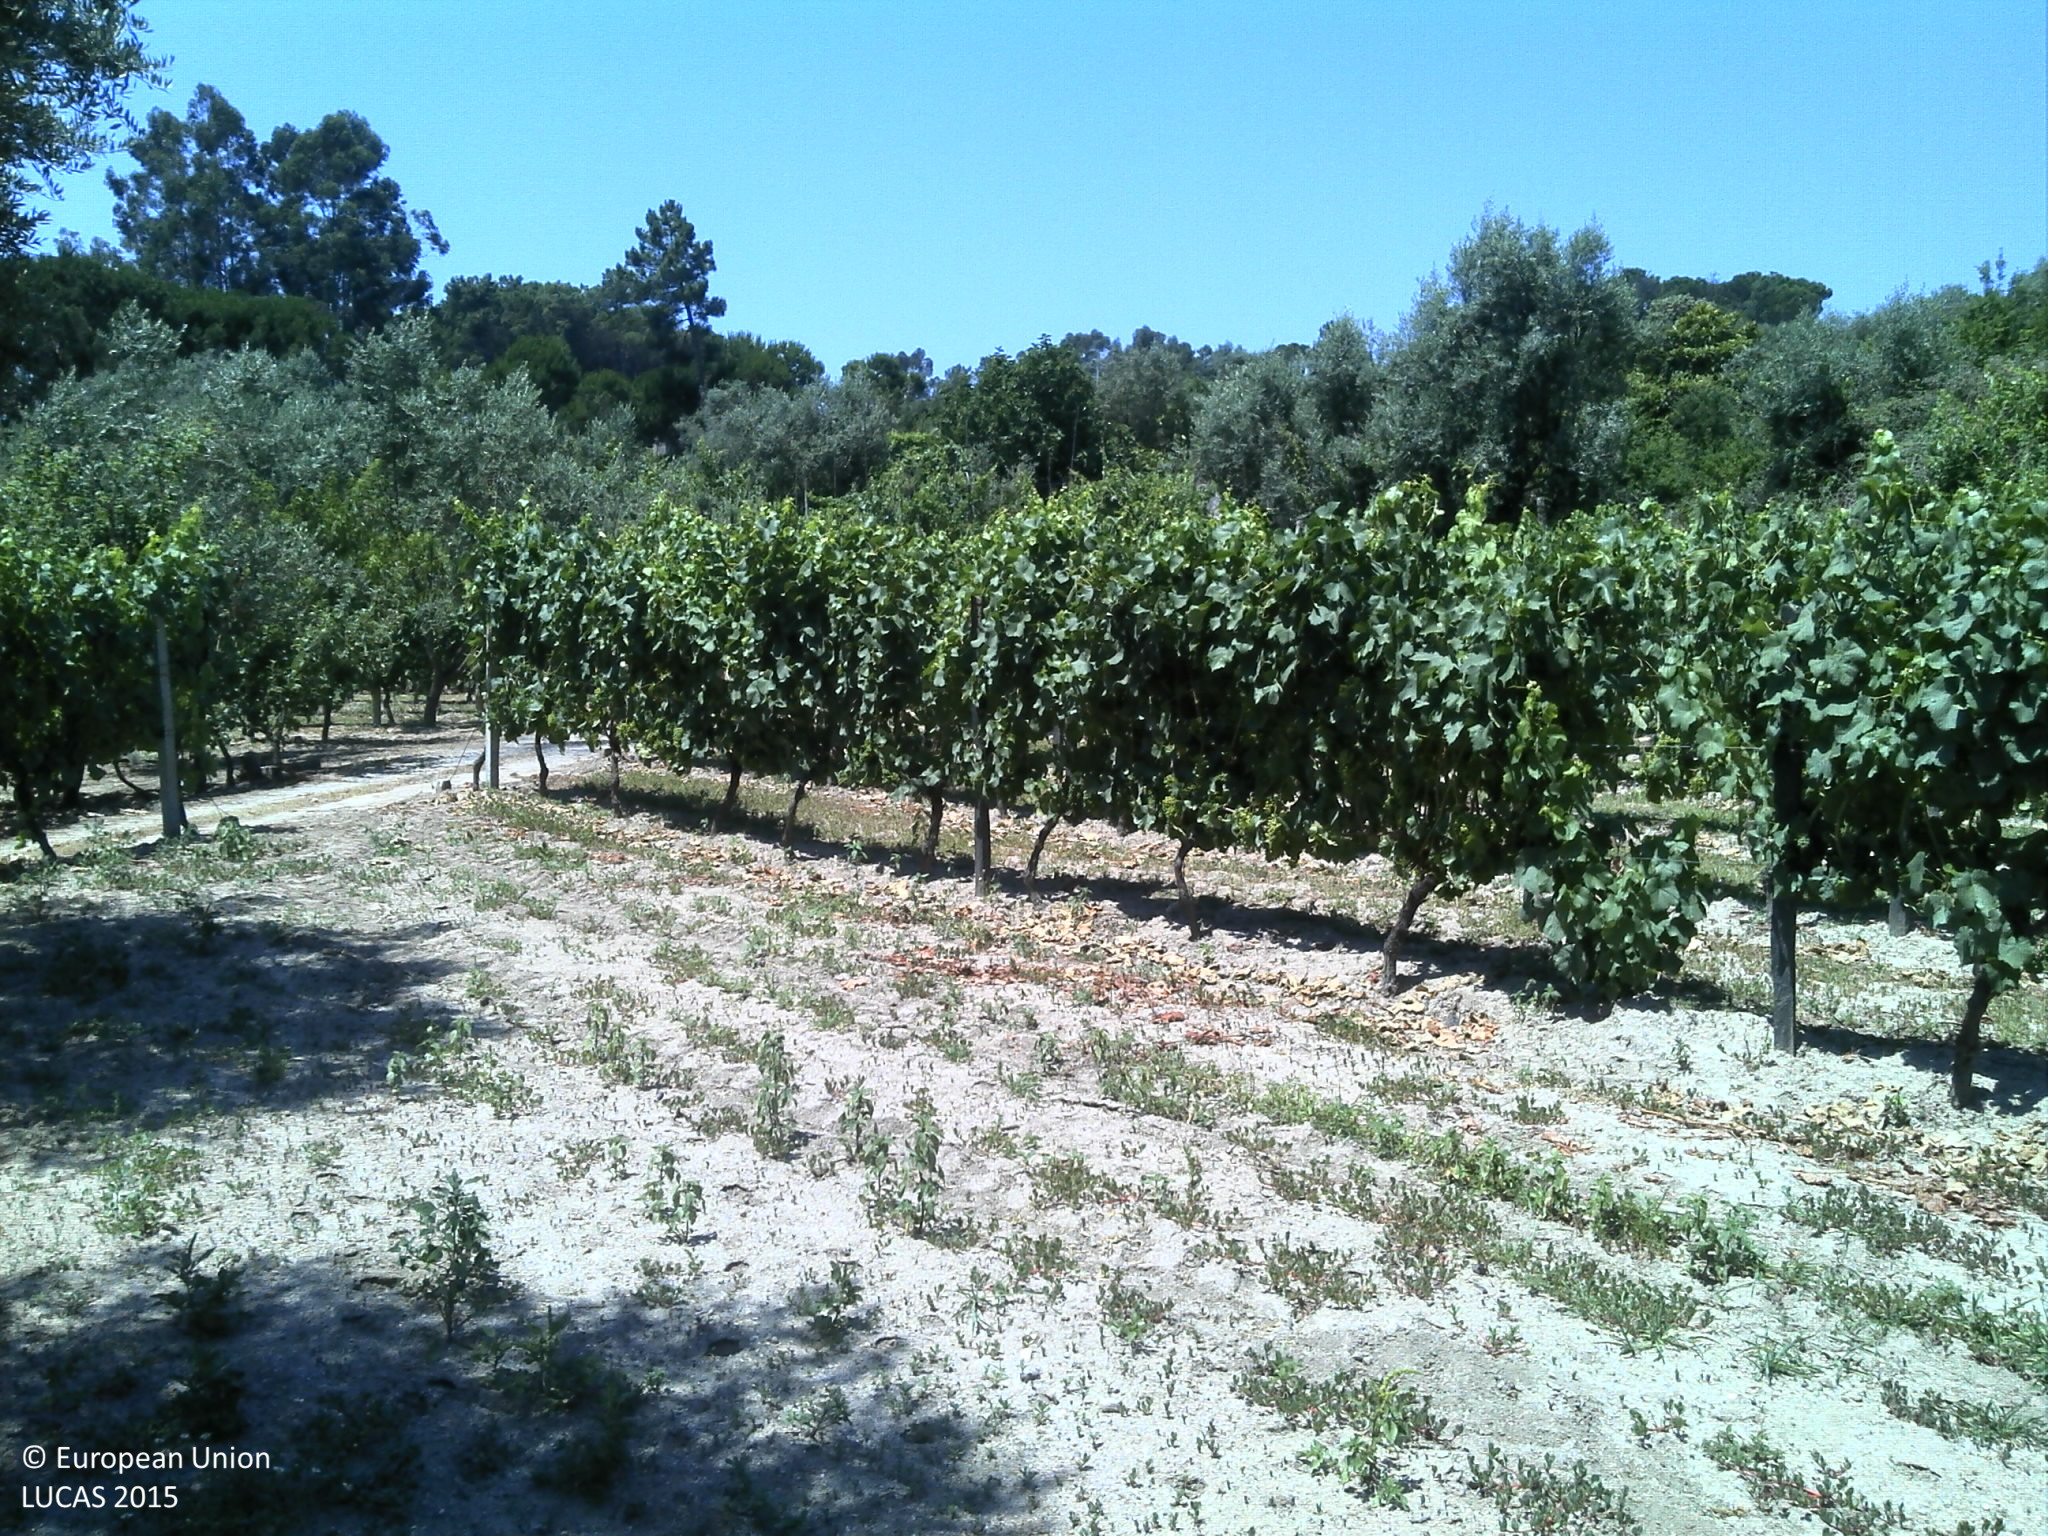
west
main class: Grassland
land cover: Grassland with sparse tree/shrub cover
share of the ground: 10 - 25 %
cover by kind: unconsolidated bare surface 70 %, herbaceous plants 25 %, broadleaved forest trees 5 %
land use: Agriculture (excluding fallow land and kitchen gardens)
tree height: > 5 m
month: June
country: PT
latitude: 40.5516
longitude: -7.9671
